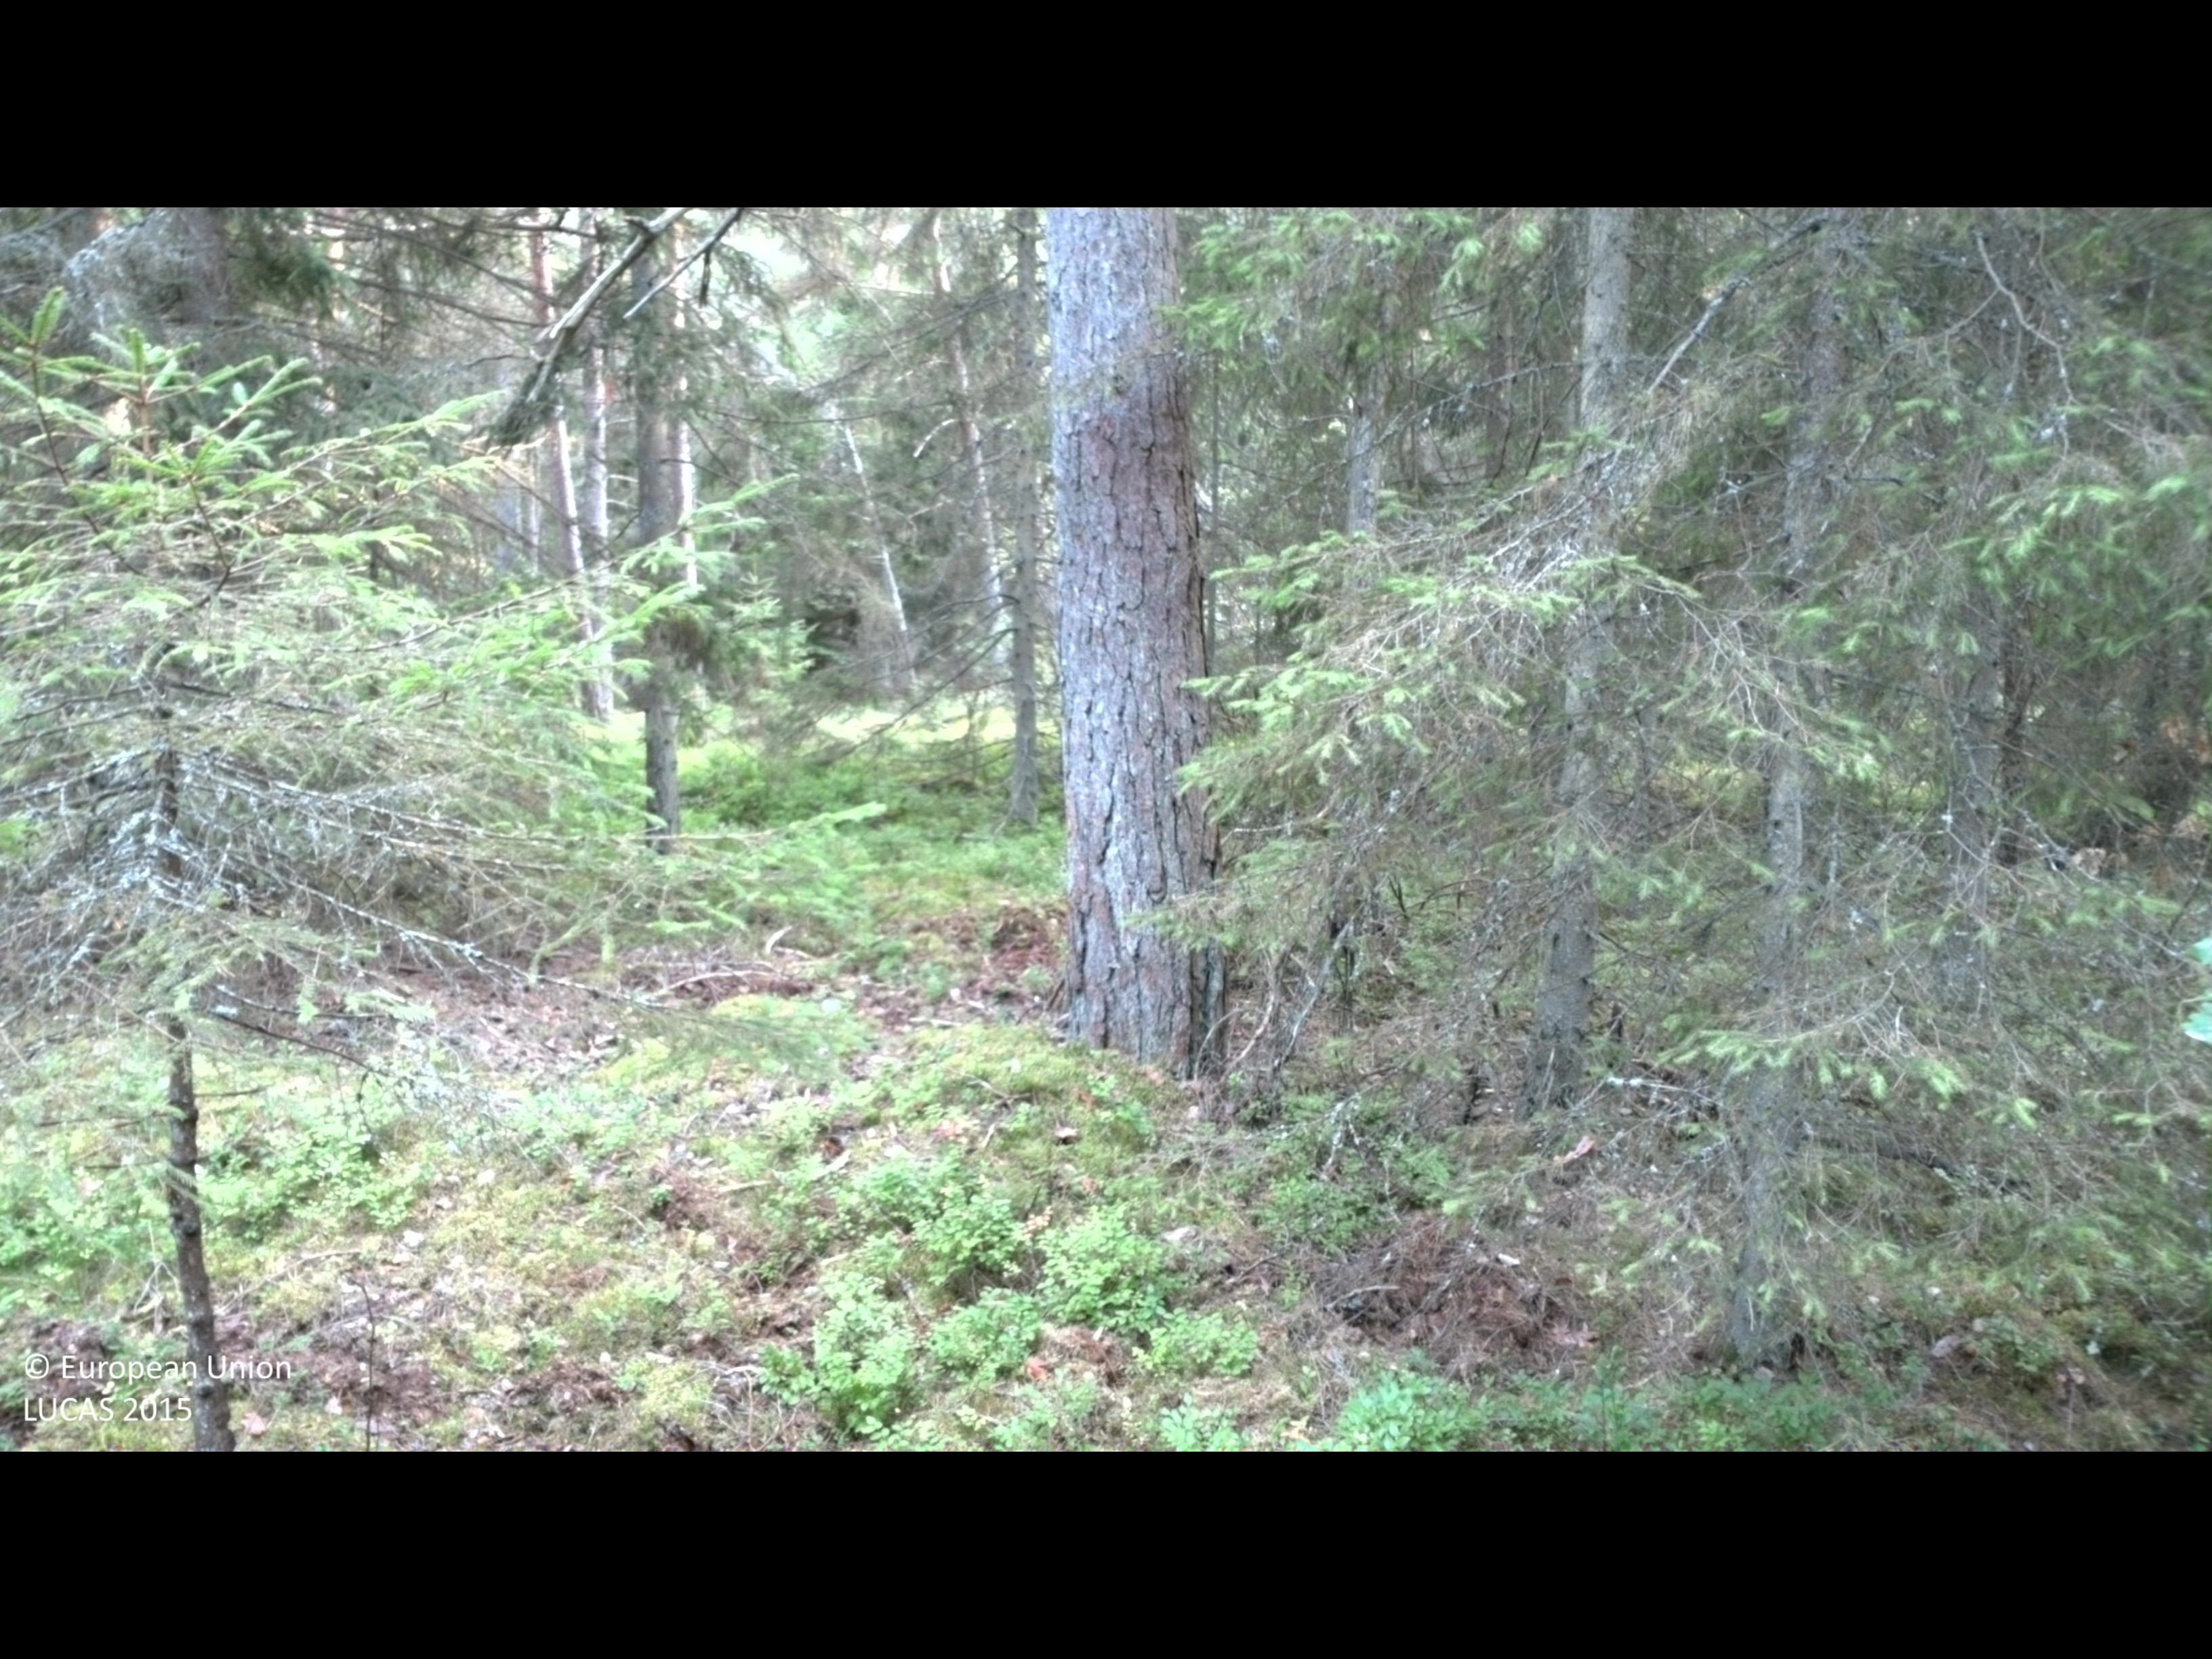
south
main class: Woodland
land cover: Spruce dominated coniferous woodland
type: boreal forest
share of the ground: 25 - 50 %
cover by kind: lichens and mosses 50 %, coniferous forest trees 35 %, shrubs 15 %
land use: Forestry
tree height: > 5 m
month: August
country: SE
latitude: 56.1725
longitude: 15.2015
